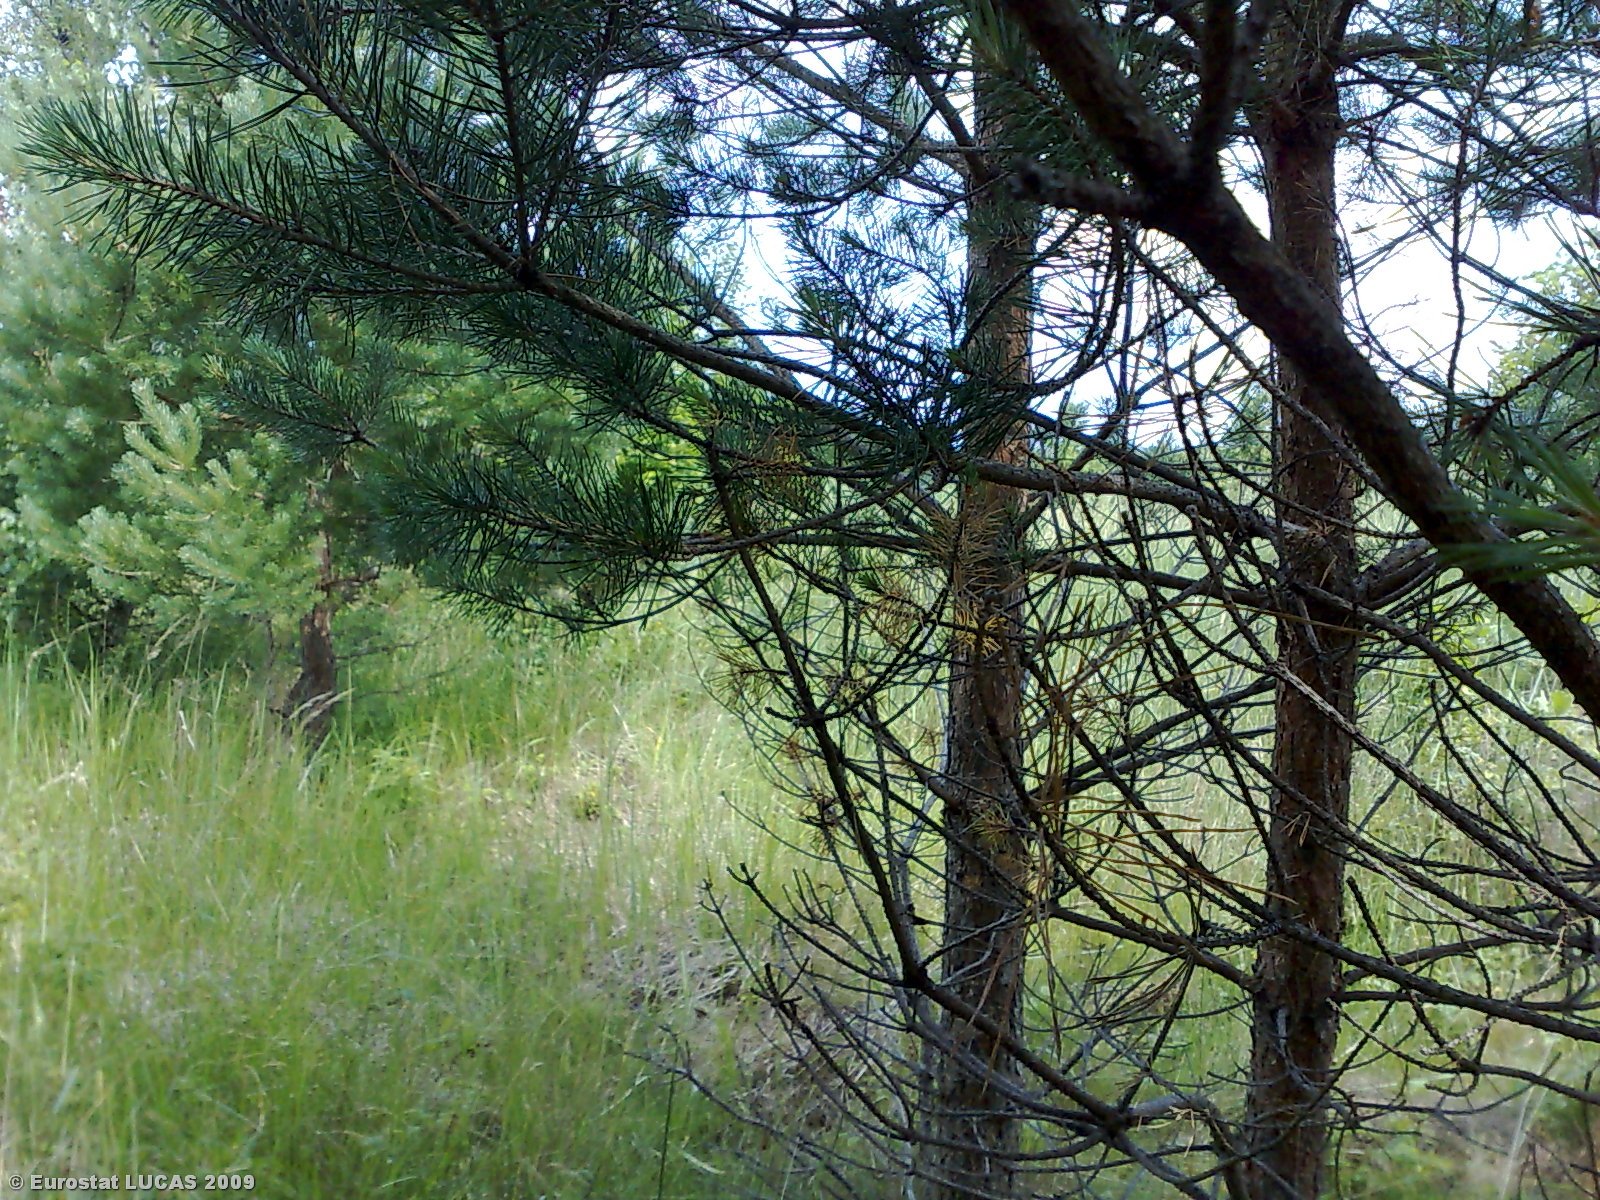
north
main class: Woodland
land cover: Coniferous woodland
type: hemiboreal forest and nemoral coniferous forest and mixed broadleaved-coniferous forest
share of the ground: > 75 %
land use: Forestry
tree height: > 5 m
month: July
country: LT
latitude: 55.5618
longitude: 22.7979
